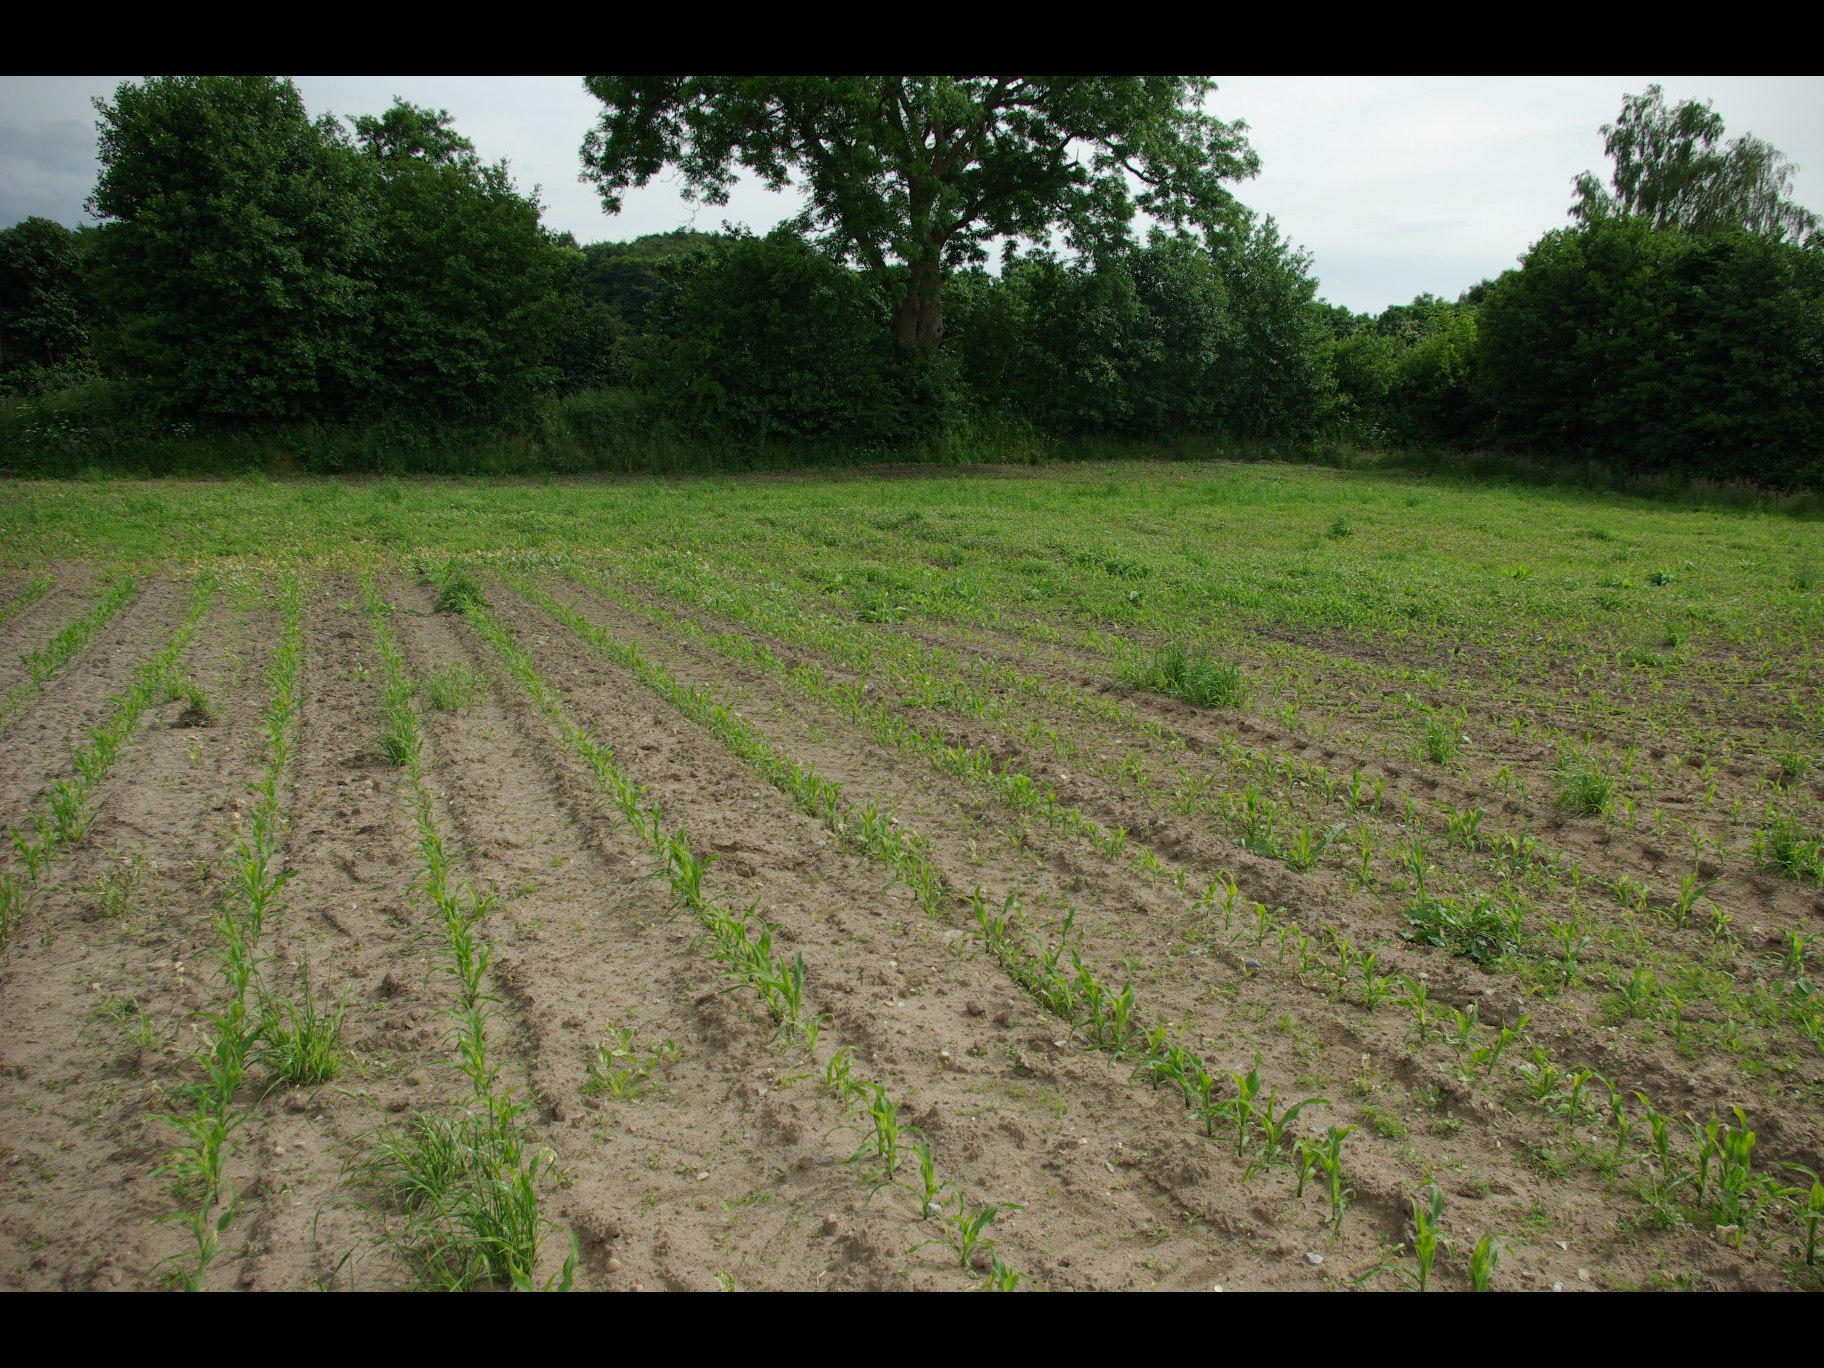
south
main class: Cropland
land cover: Maize
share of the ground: 10 - 25 %
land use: Agriculture (excluding fallow land and kitchen gardens)
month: June
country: DE
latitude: 54.4258
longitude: 9.6457
